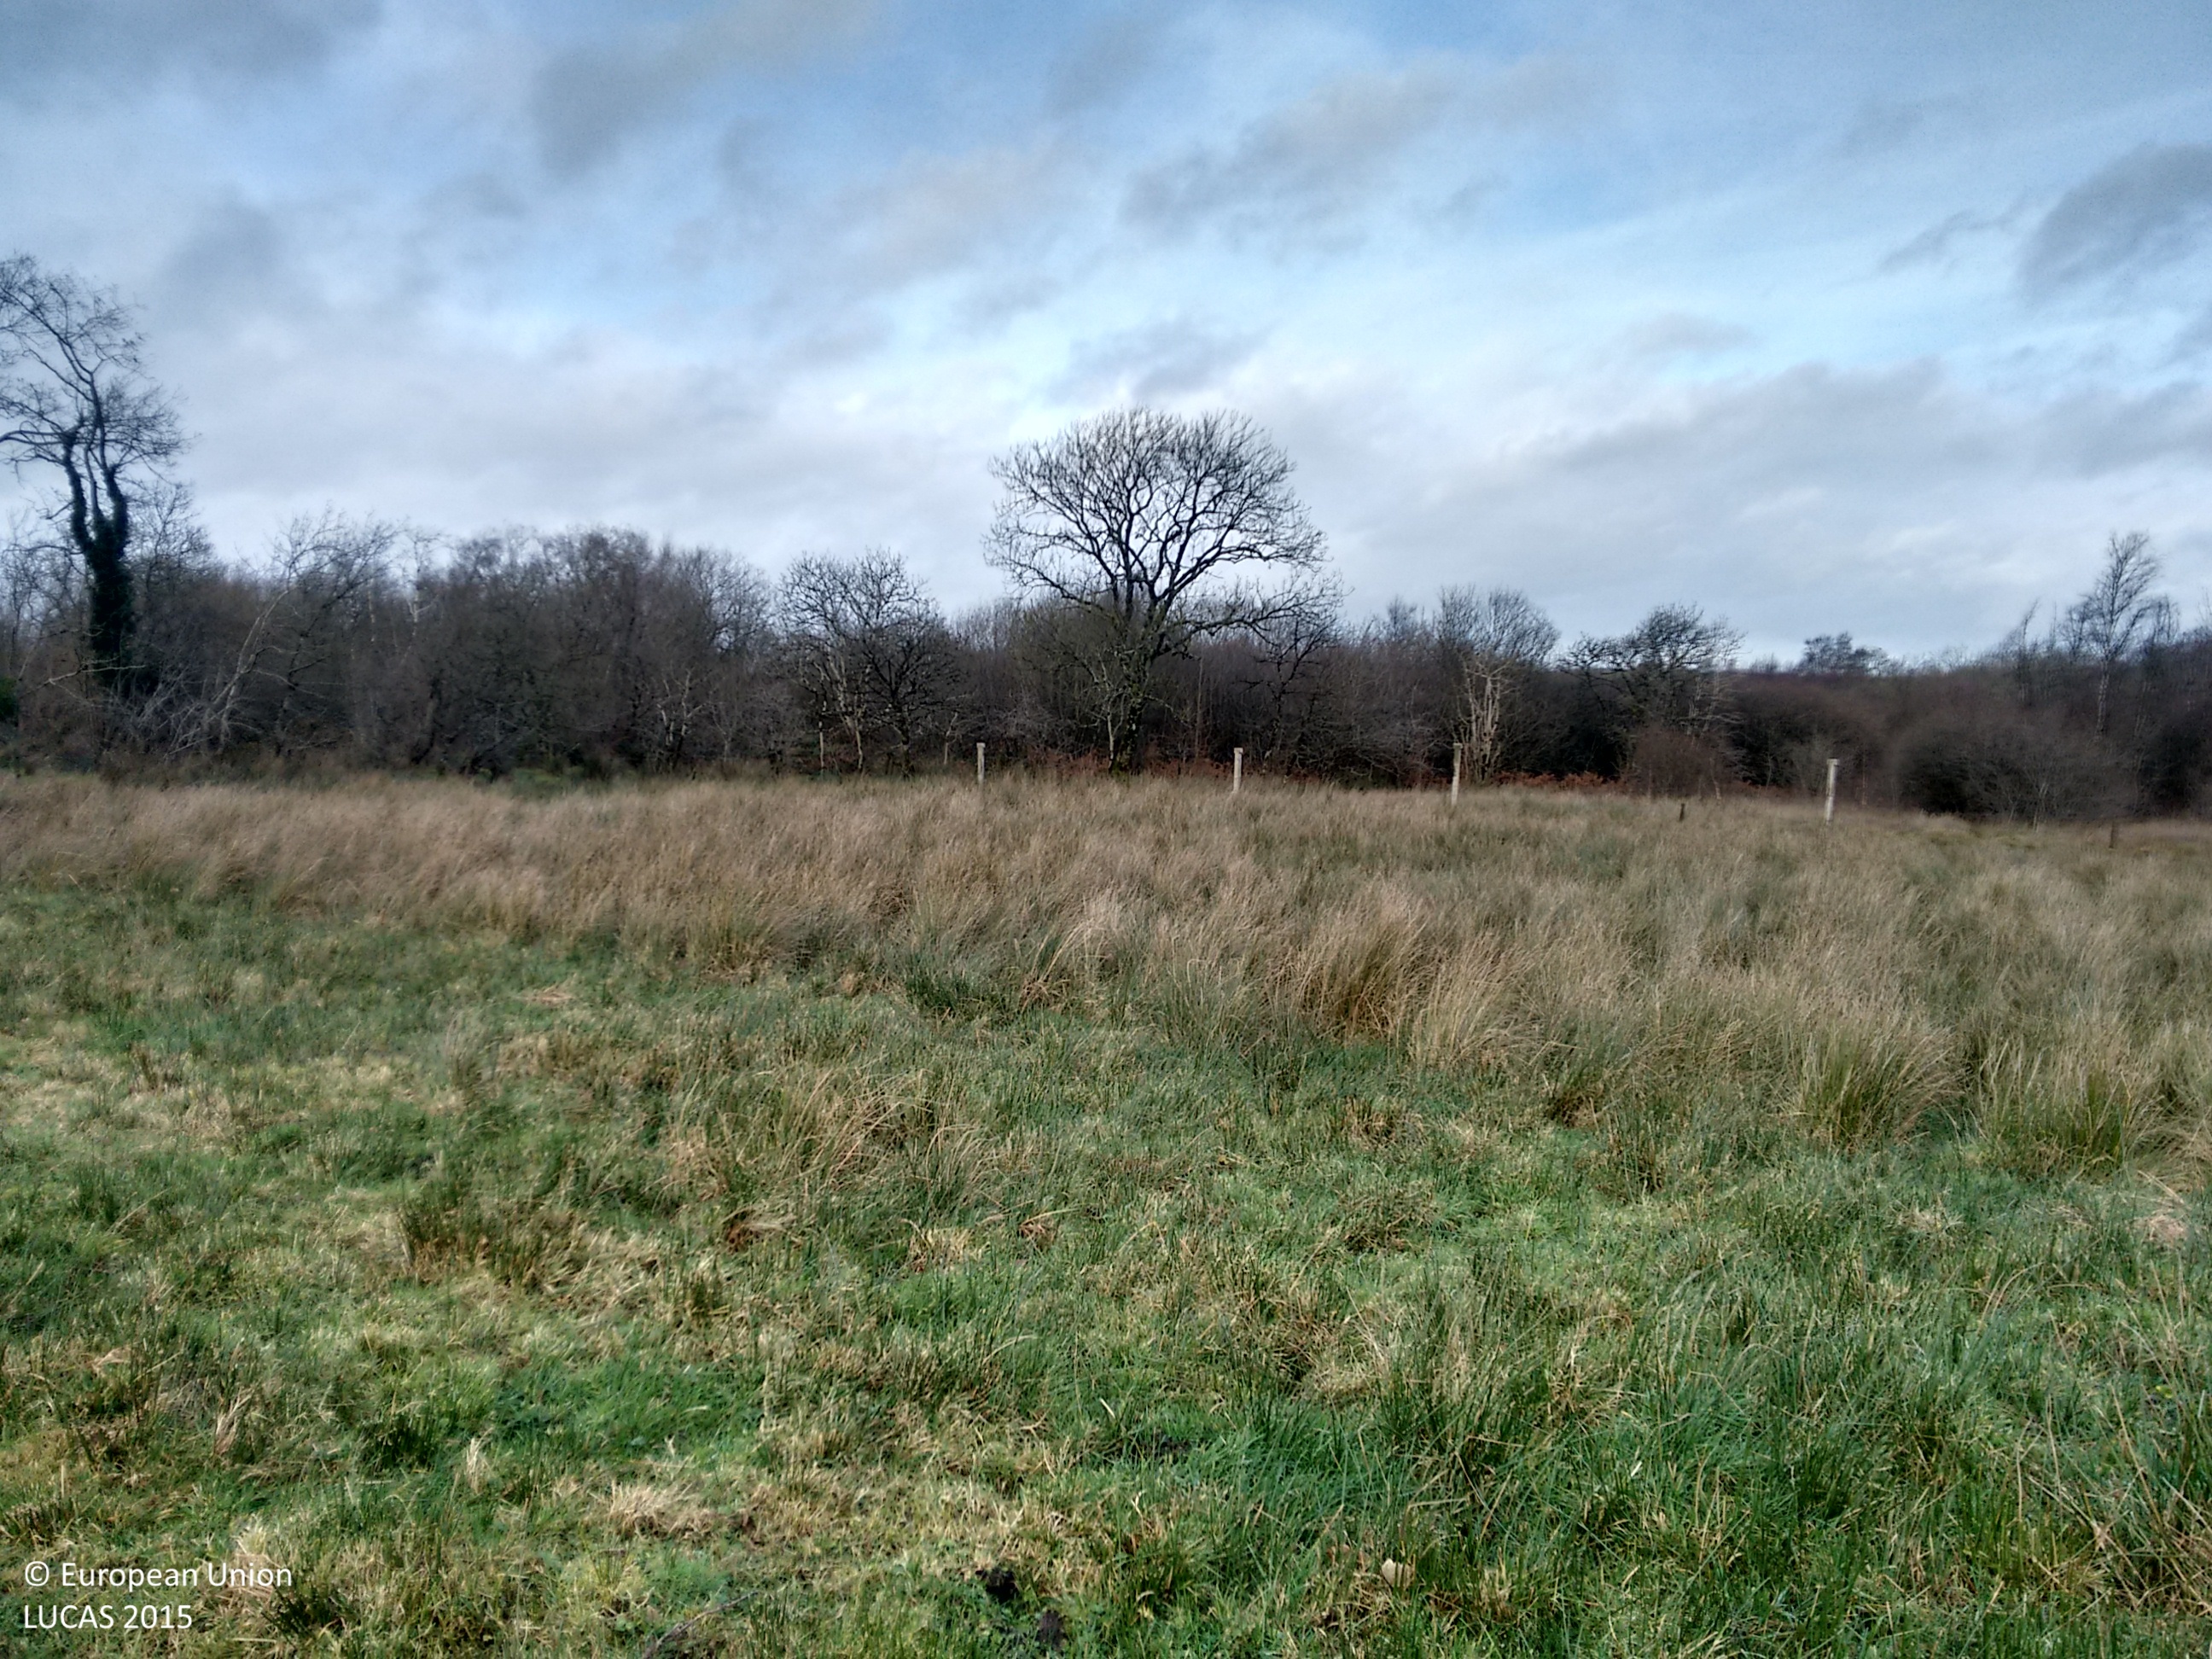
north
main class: Grassland
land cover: Grassland without tree/shrub cover
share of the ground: > 75 %
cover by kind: herbaceous plants 100 %
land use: Agriculture (excluding fallow land and kitchen gardens)
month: December
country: IE
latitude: 53.9690
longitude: -6.8910
